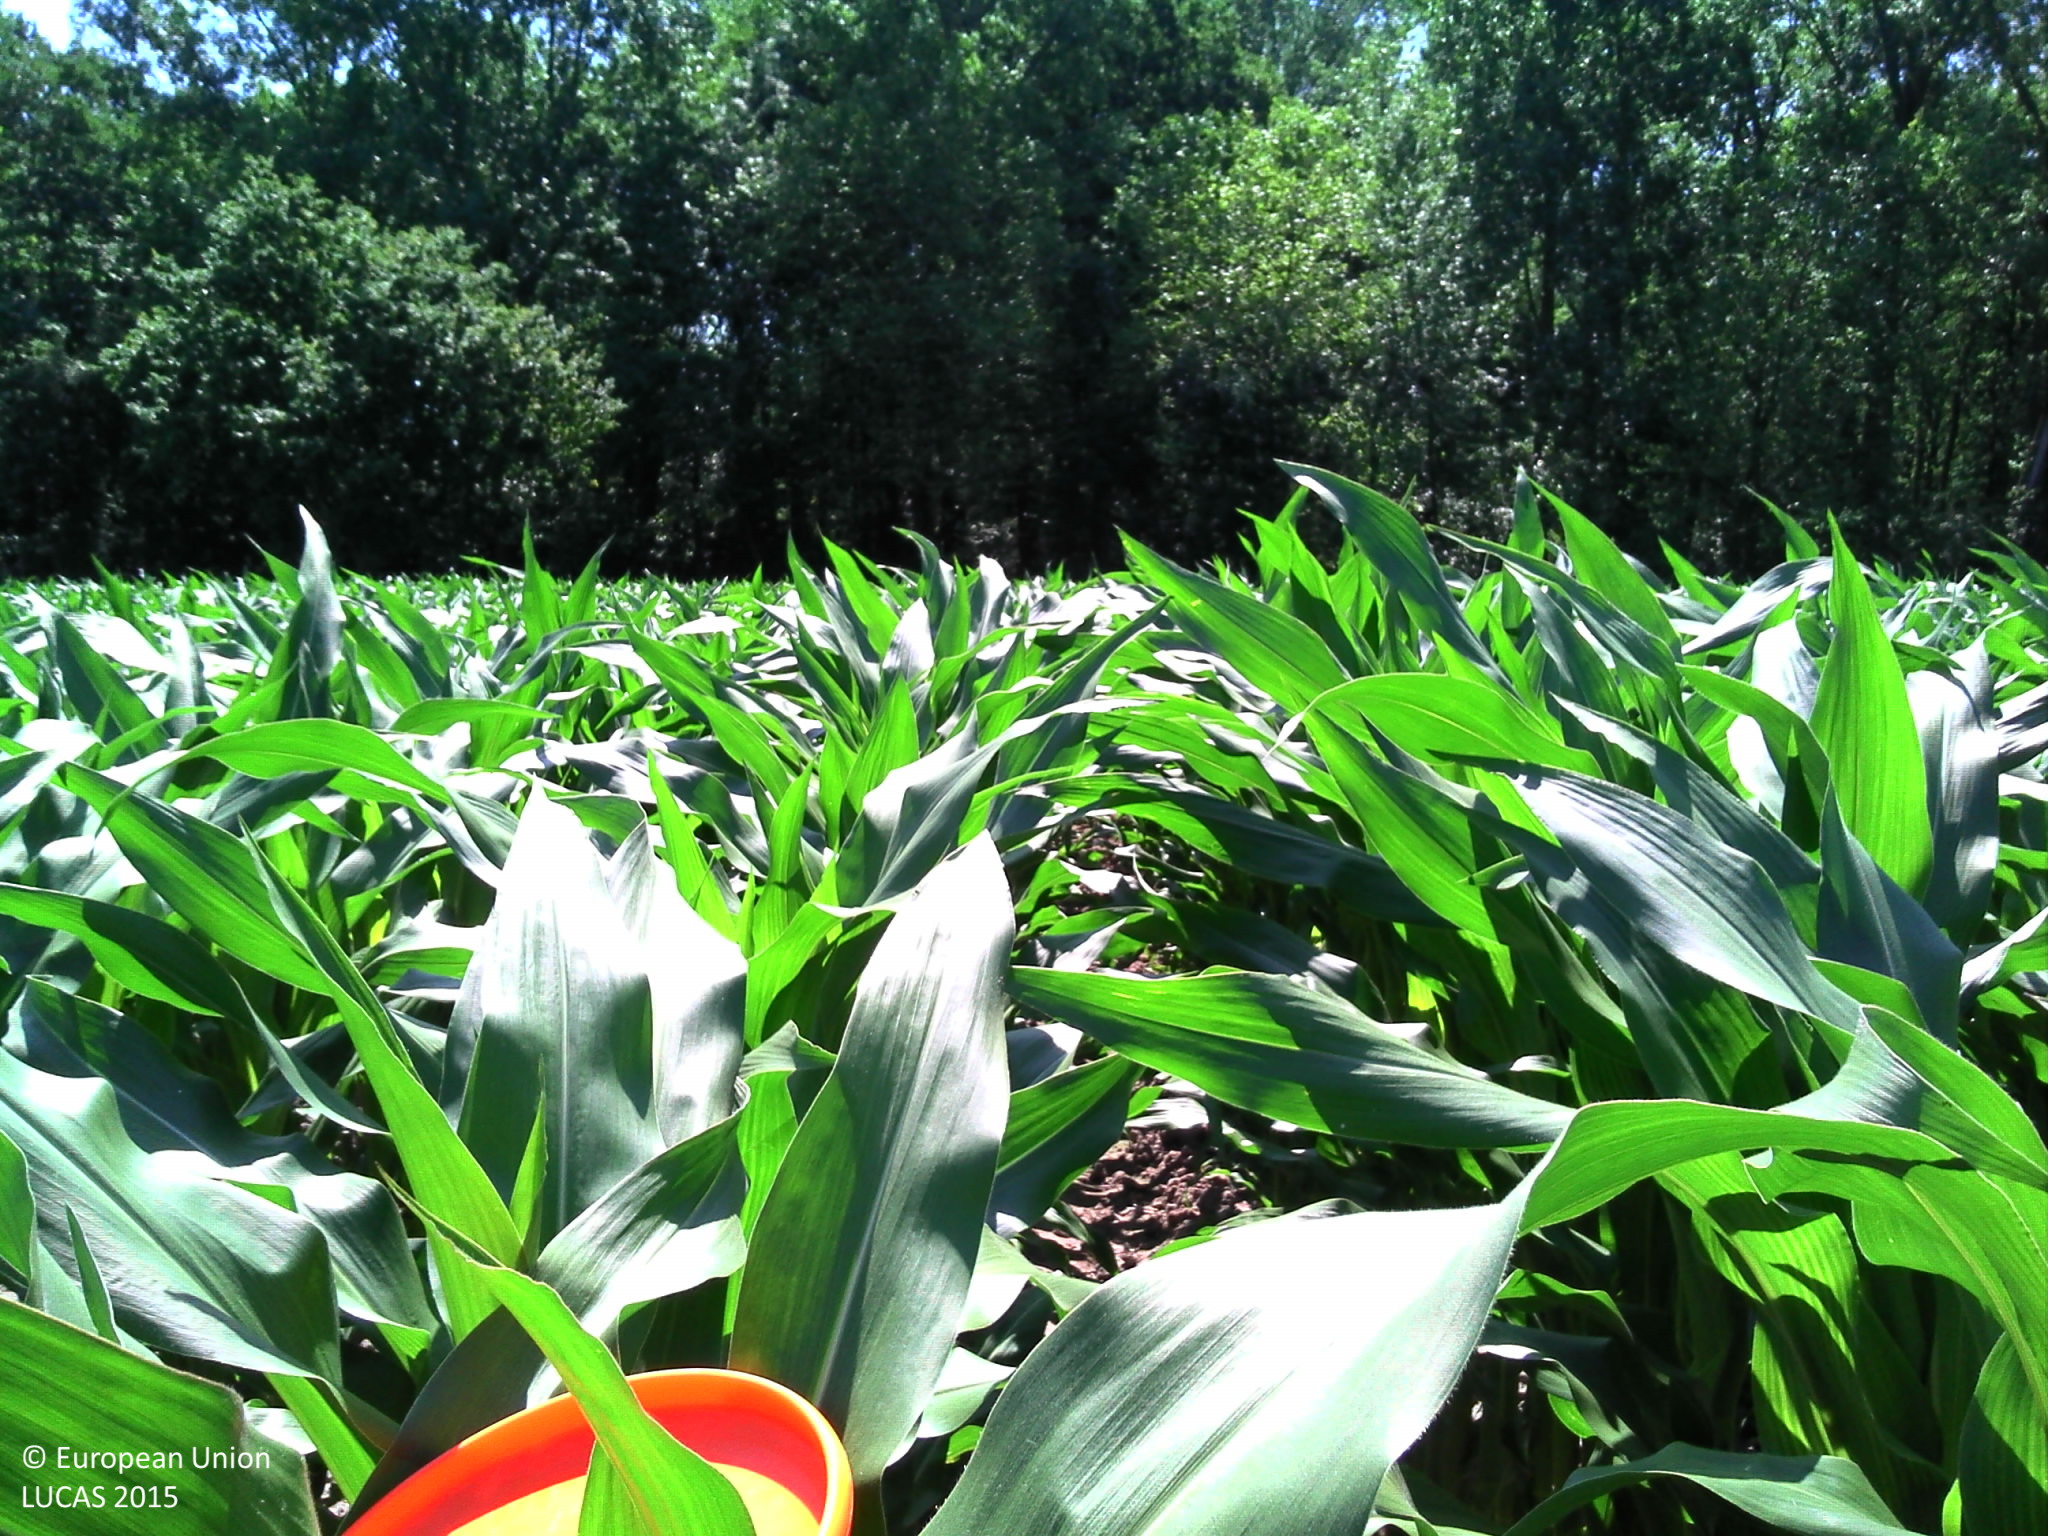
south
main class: Cropland
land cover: Maize
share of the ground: > 75 %
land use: Agriculture (excluding fallow land and kitchen gardens)
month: June
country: BE
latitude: 51.1620
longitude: 3.6581
